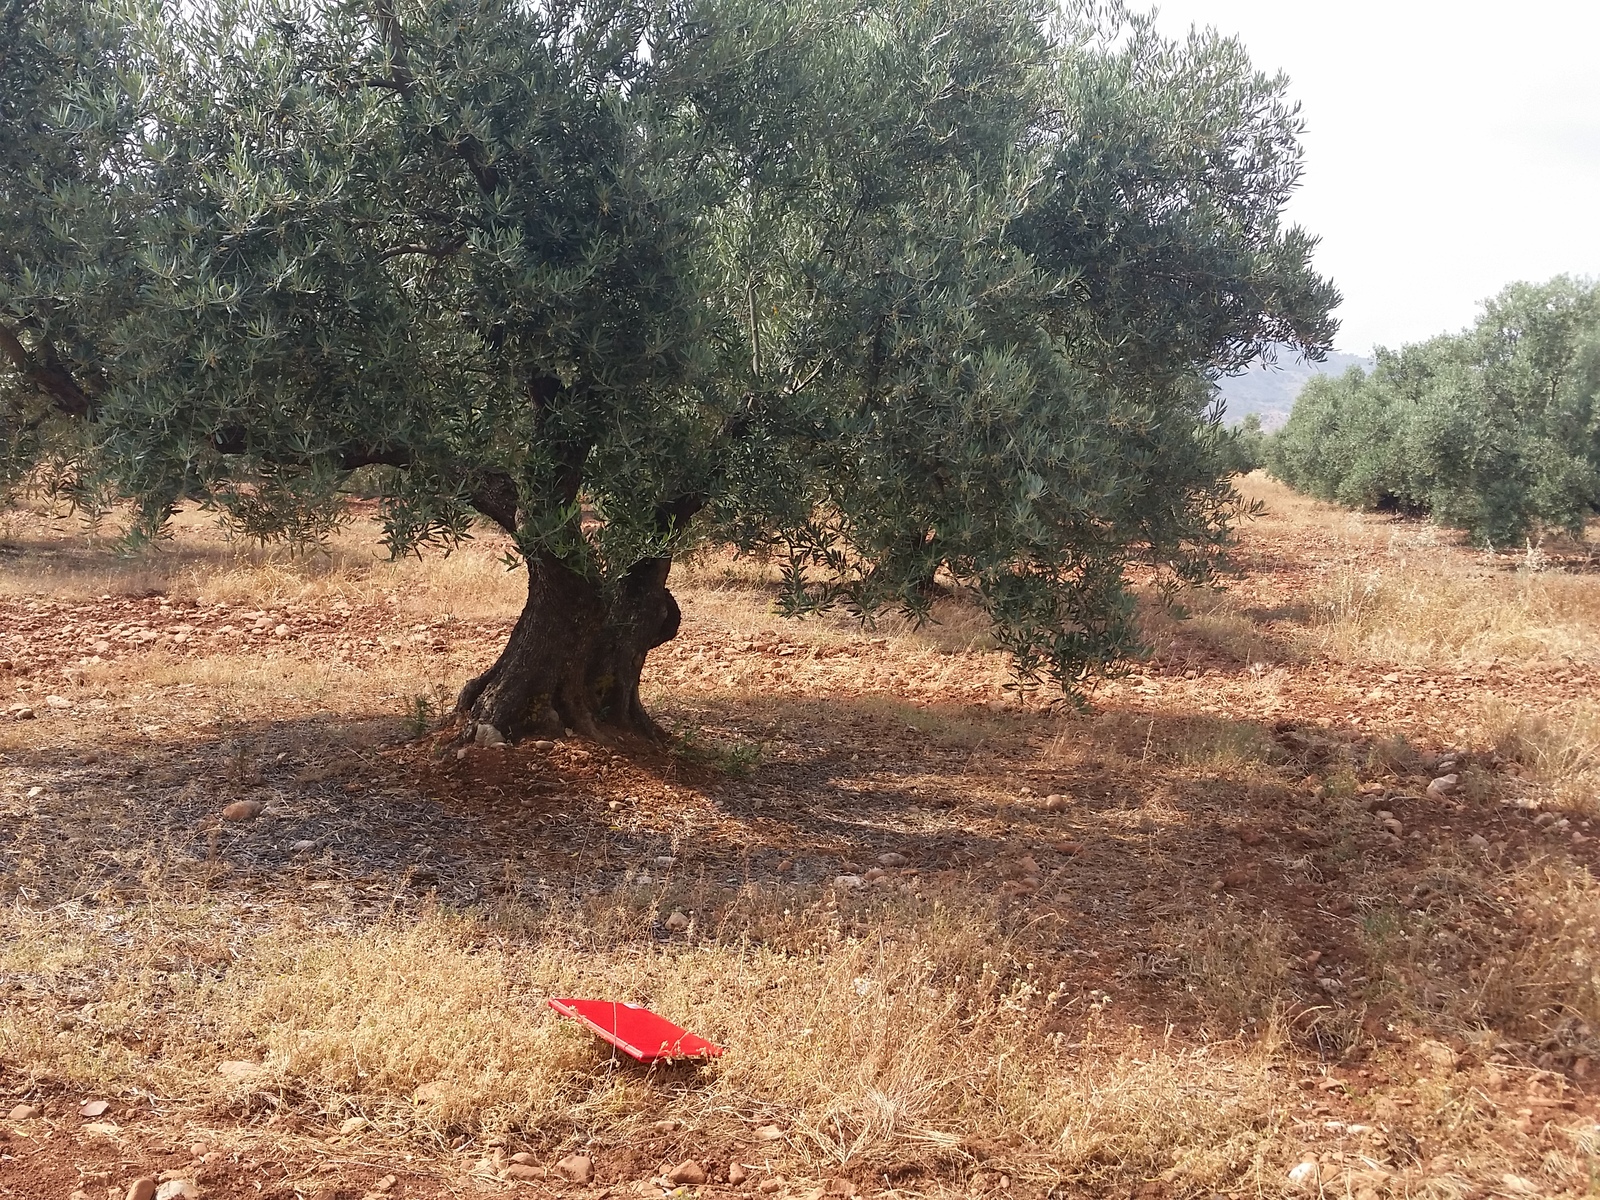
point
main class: Cropland
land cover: Olive groves
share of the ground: 50 - 75 %
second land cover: Grassland without tree/shrub cover
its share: 25 - 50 %
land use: Agriculture (excluding fallow land and kitchen gardens)
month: June
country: ES
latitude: 38.5711
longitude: -2.6149
